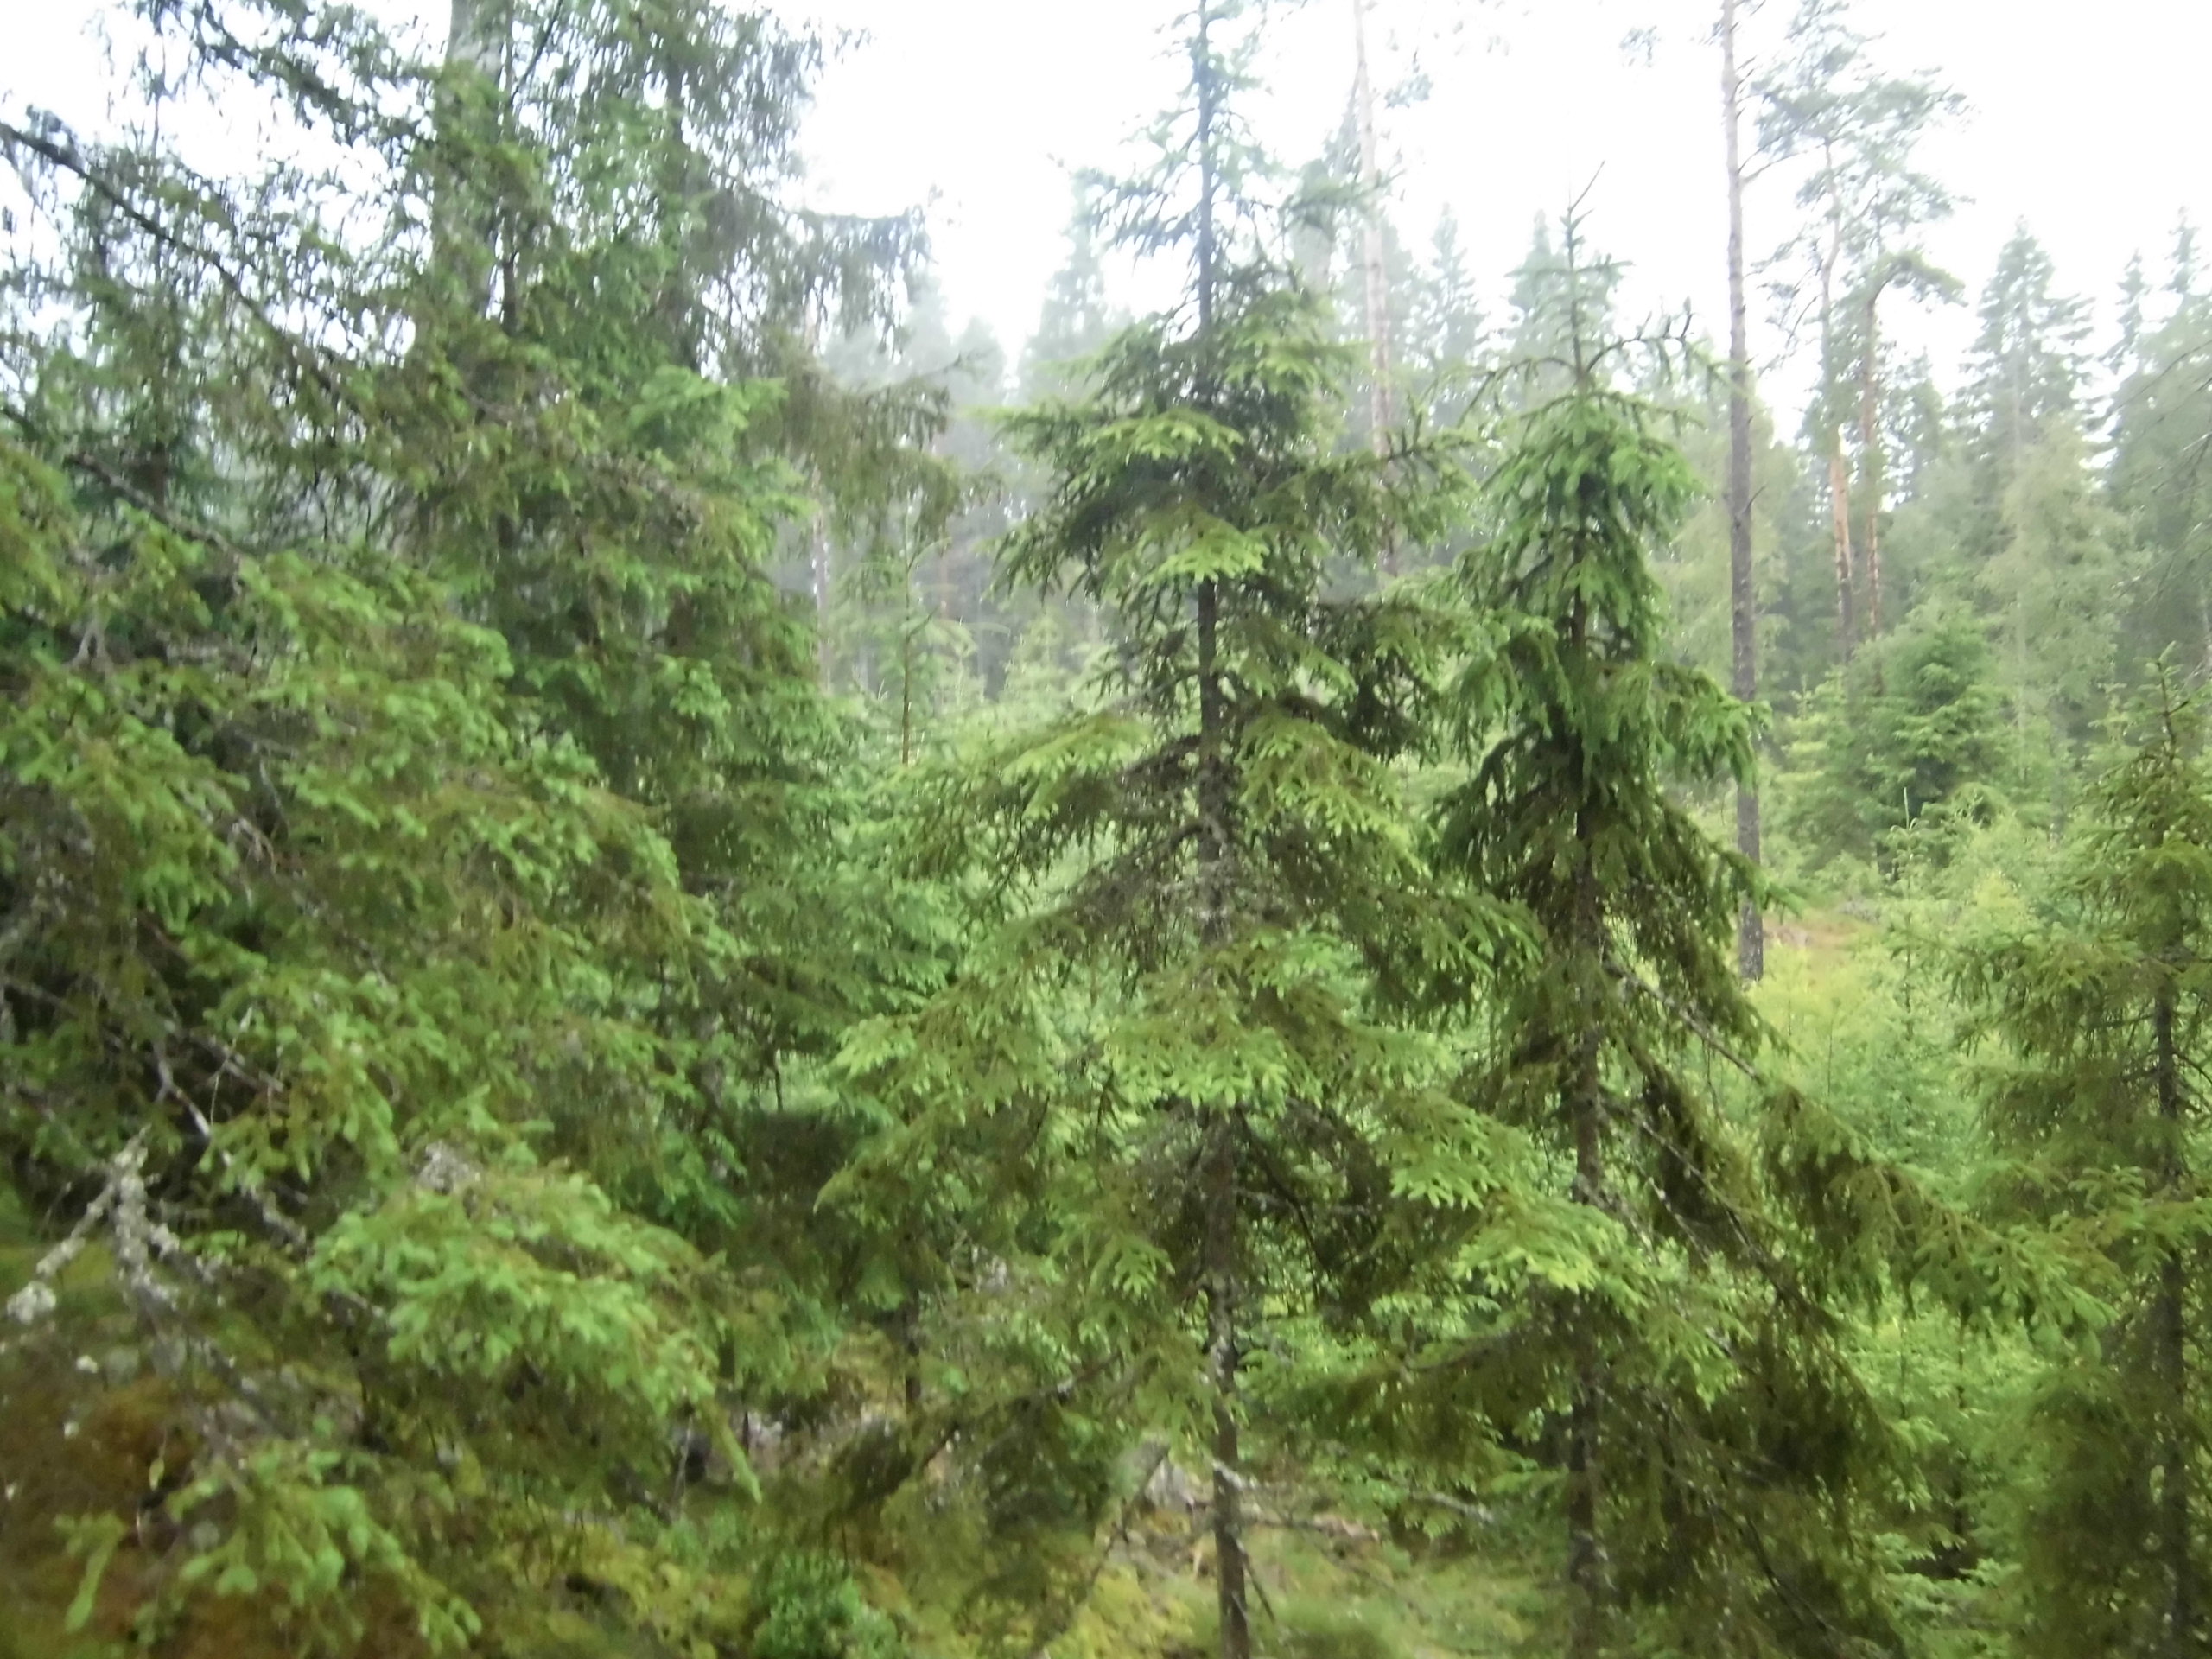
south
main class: Woodland
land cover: Spruce dominated coniferous woodland
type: boreal forest
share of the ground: 50 - 75 %
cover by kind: coniferous forest trees 45 %, shrubs 25 %, lichens and mosses 15 %, herbaceous plants 10 %, broadleaved forest trees 5 %
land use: Forestry
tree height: > 5 m
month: July
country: SE
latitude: 57.2211
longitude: 15.1142
